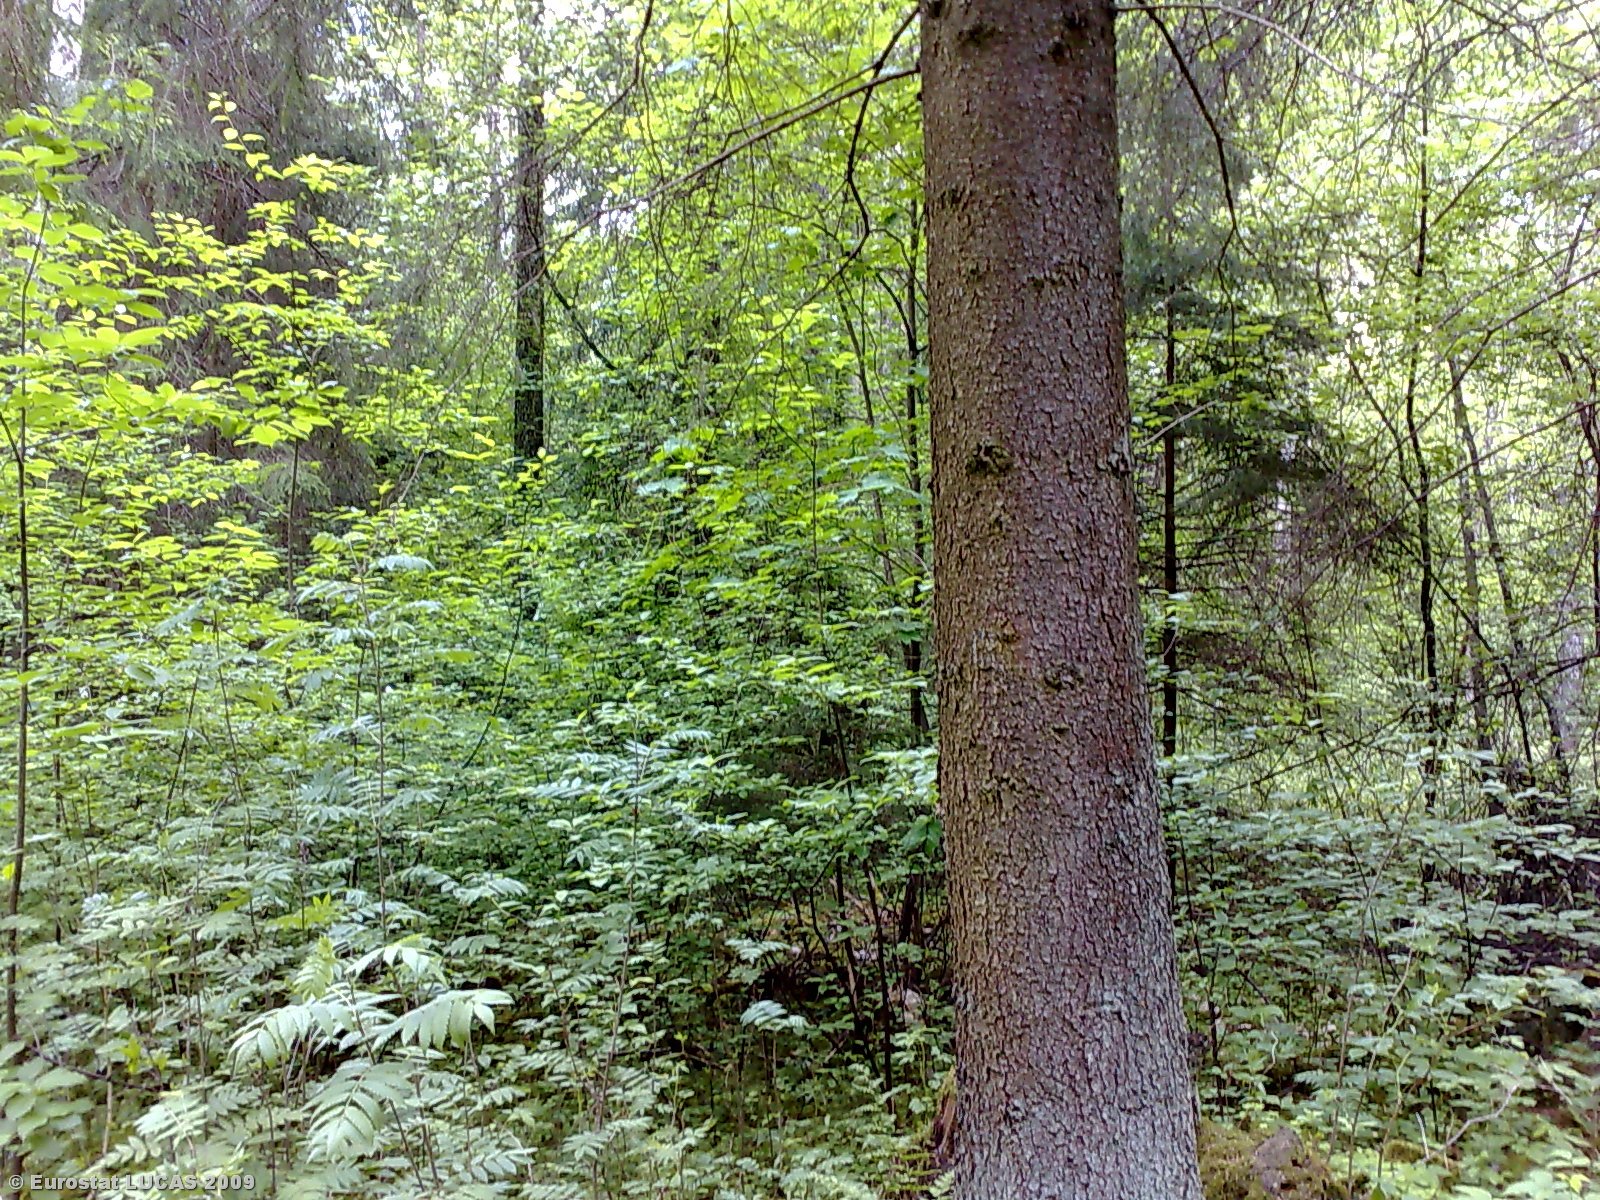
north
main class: Woodland
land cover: Mixed woodland
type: hemiboreal forest and nemoral coniferous forest and mixed broadleaved-coniferous forest
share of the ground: > 75 %
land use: Forestry
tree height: > 5 m
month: May
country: LT
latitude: 55.5968
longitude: 23.8446
